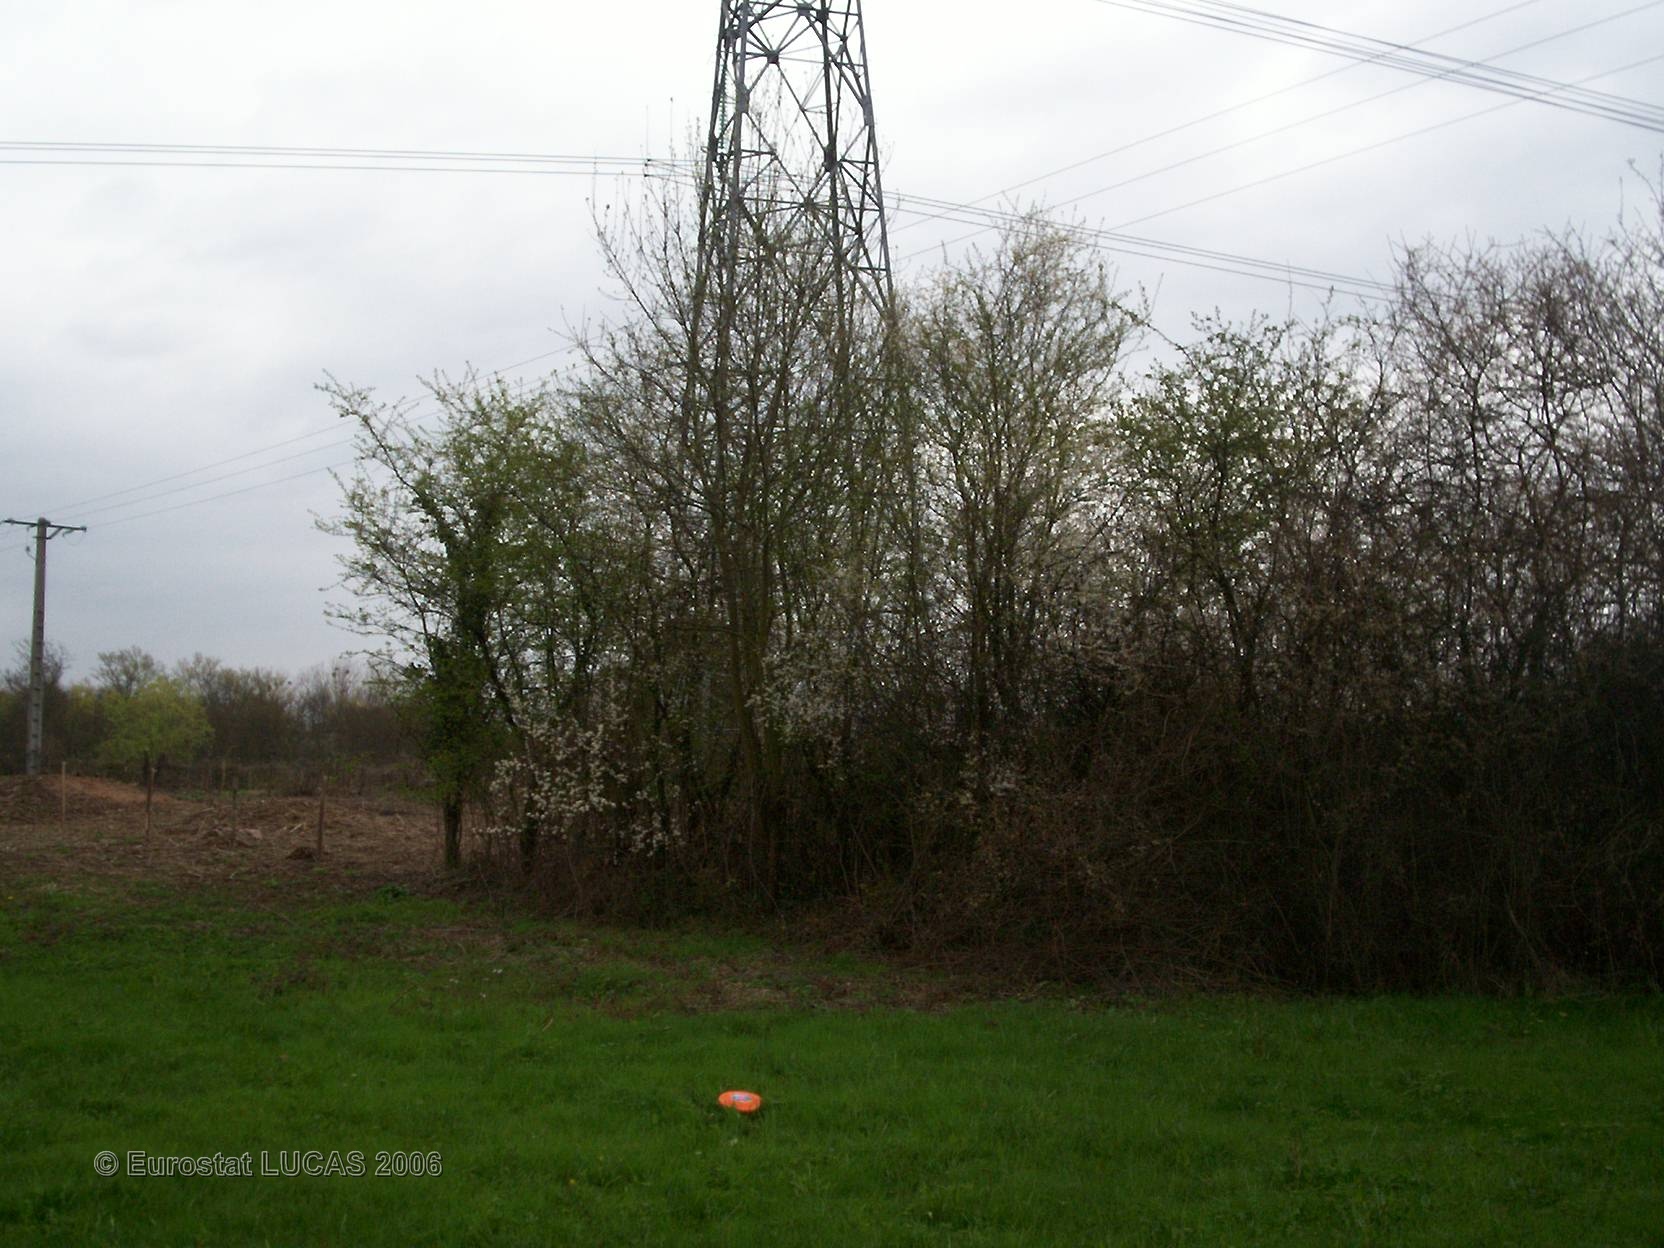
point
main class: Grassland
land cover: Grassland without tree/shrub cover
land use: Agriculture (excluding fallow land and kitchen gardens)
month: April
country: FR
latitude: 46.2044
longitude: 4.7535
